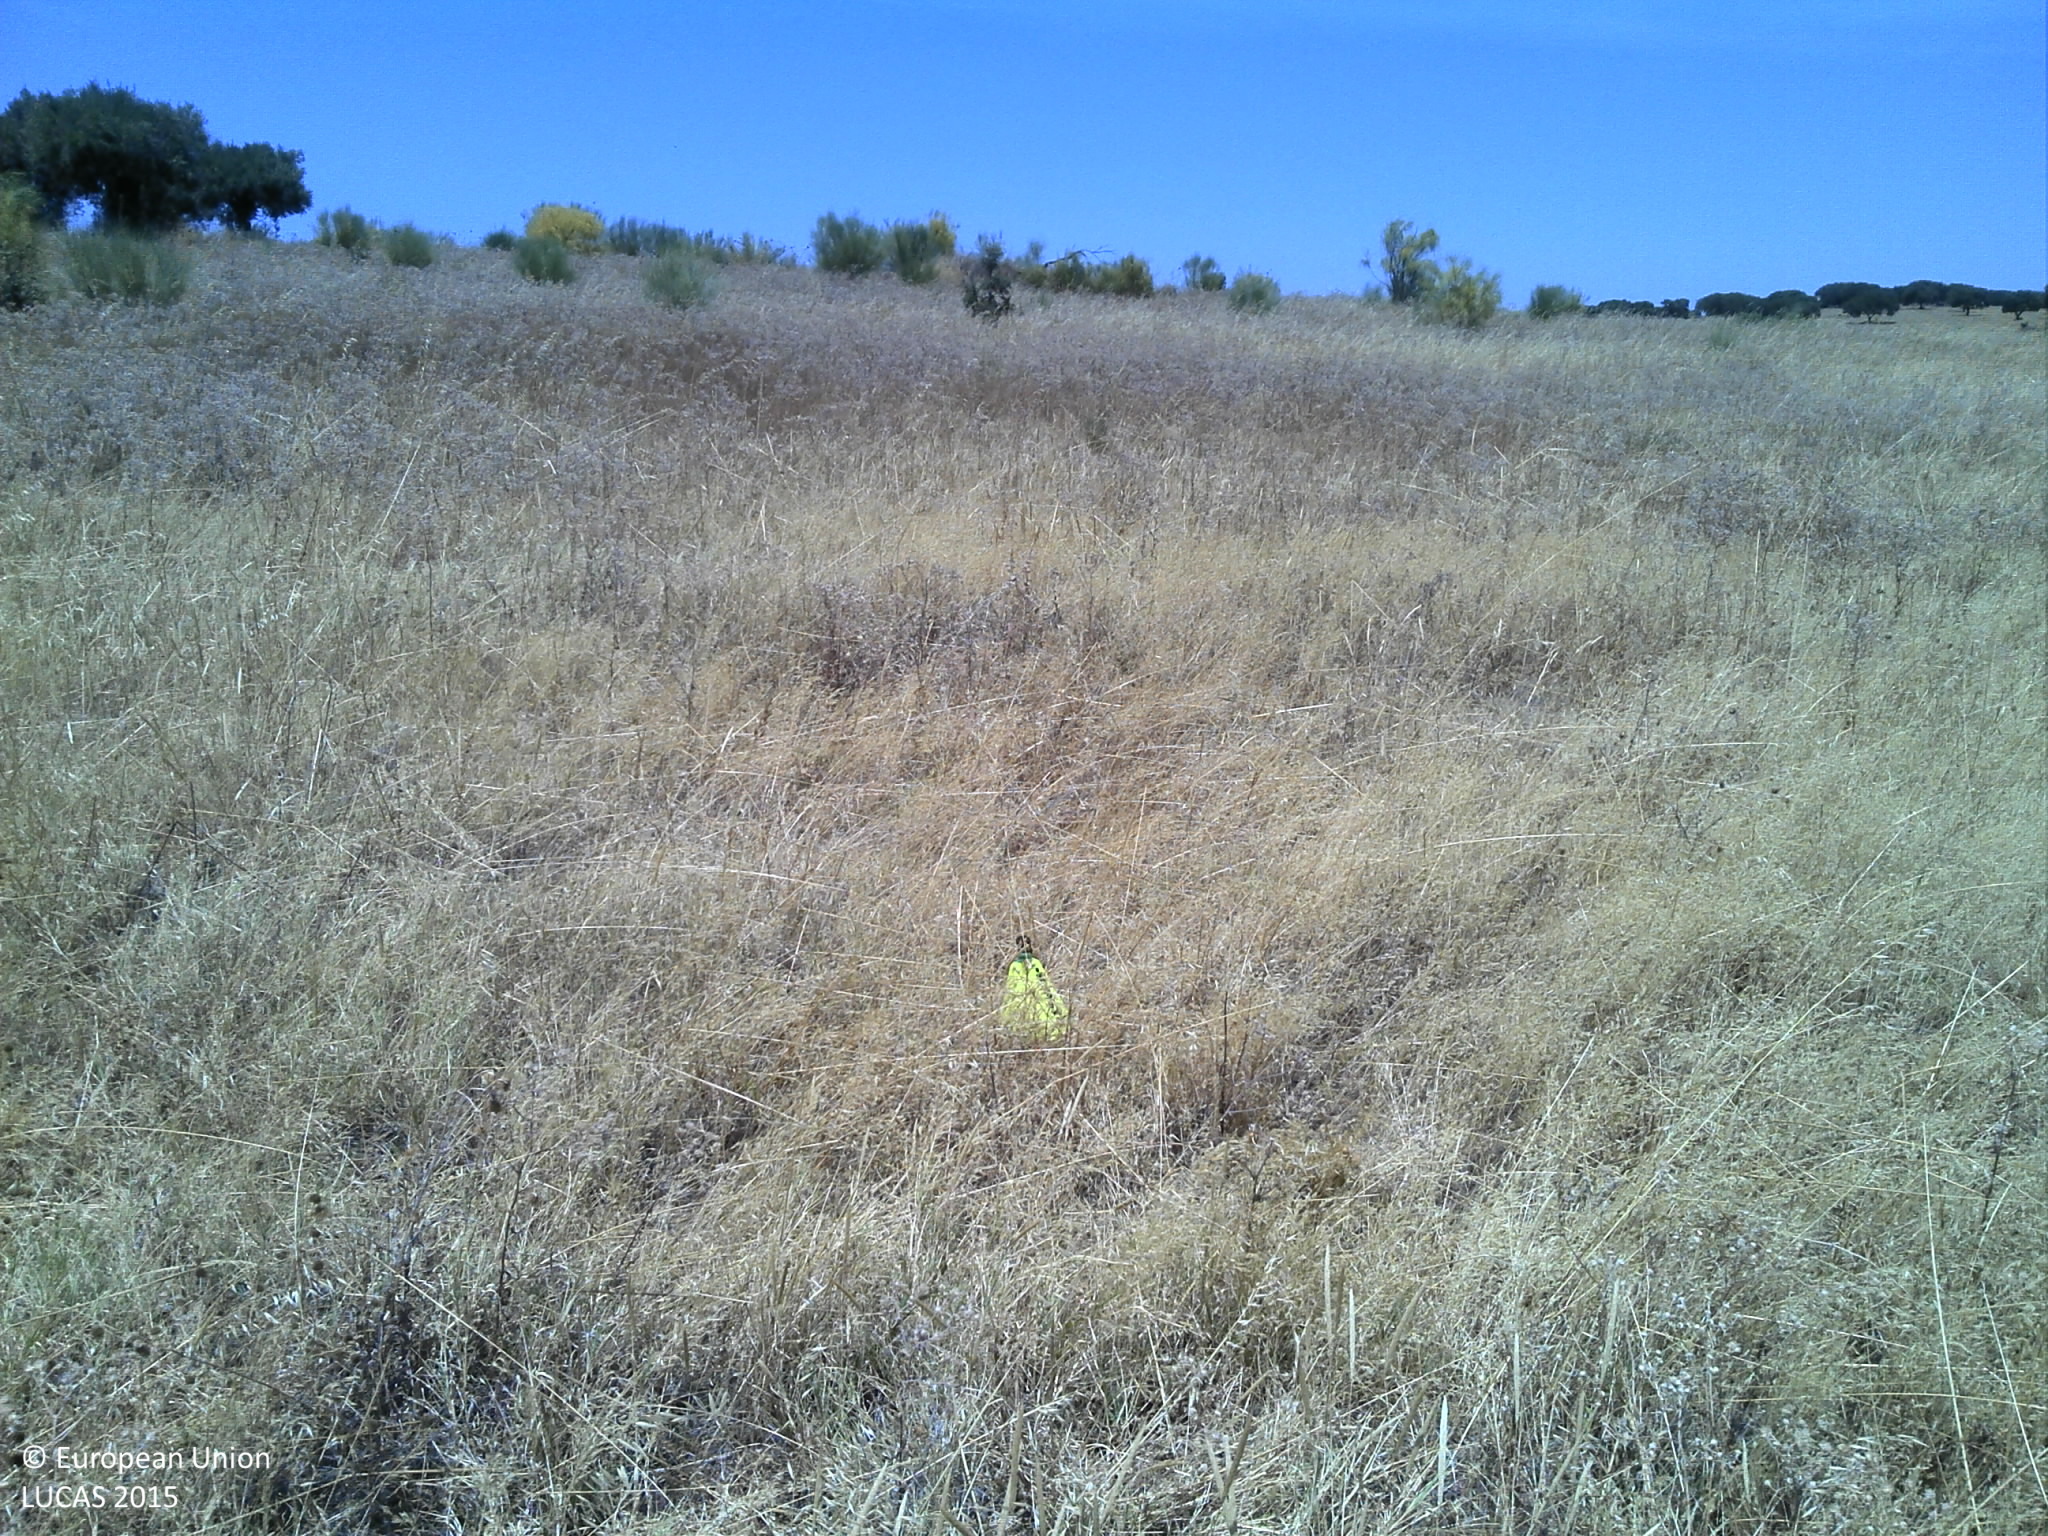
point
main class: Grassland
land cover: Grassland without tree/shrub cover
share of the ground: 25 - 50 %
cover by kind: herbaceous plants 50 %, unconsolidated bare surface 50 %
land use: Agriculture (excluding fallow land and kitchen gardens)
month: July
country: PT
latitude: 38.4178
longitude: -7.4229
